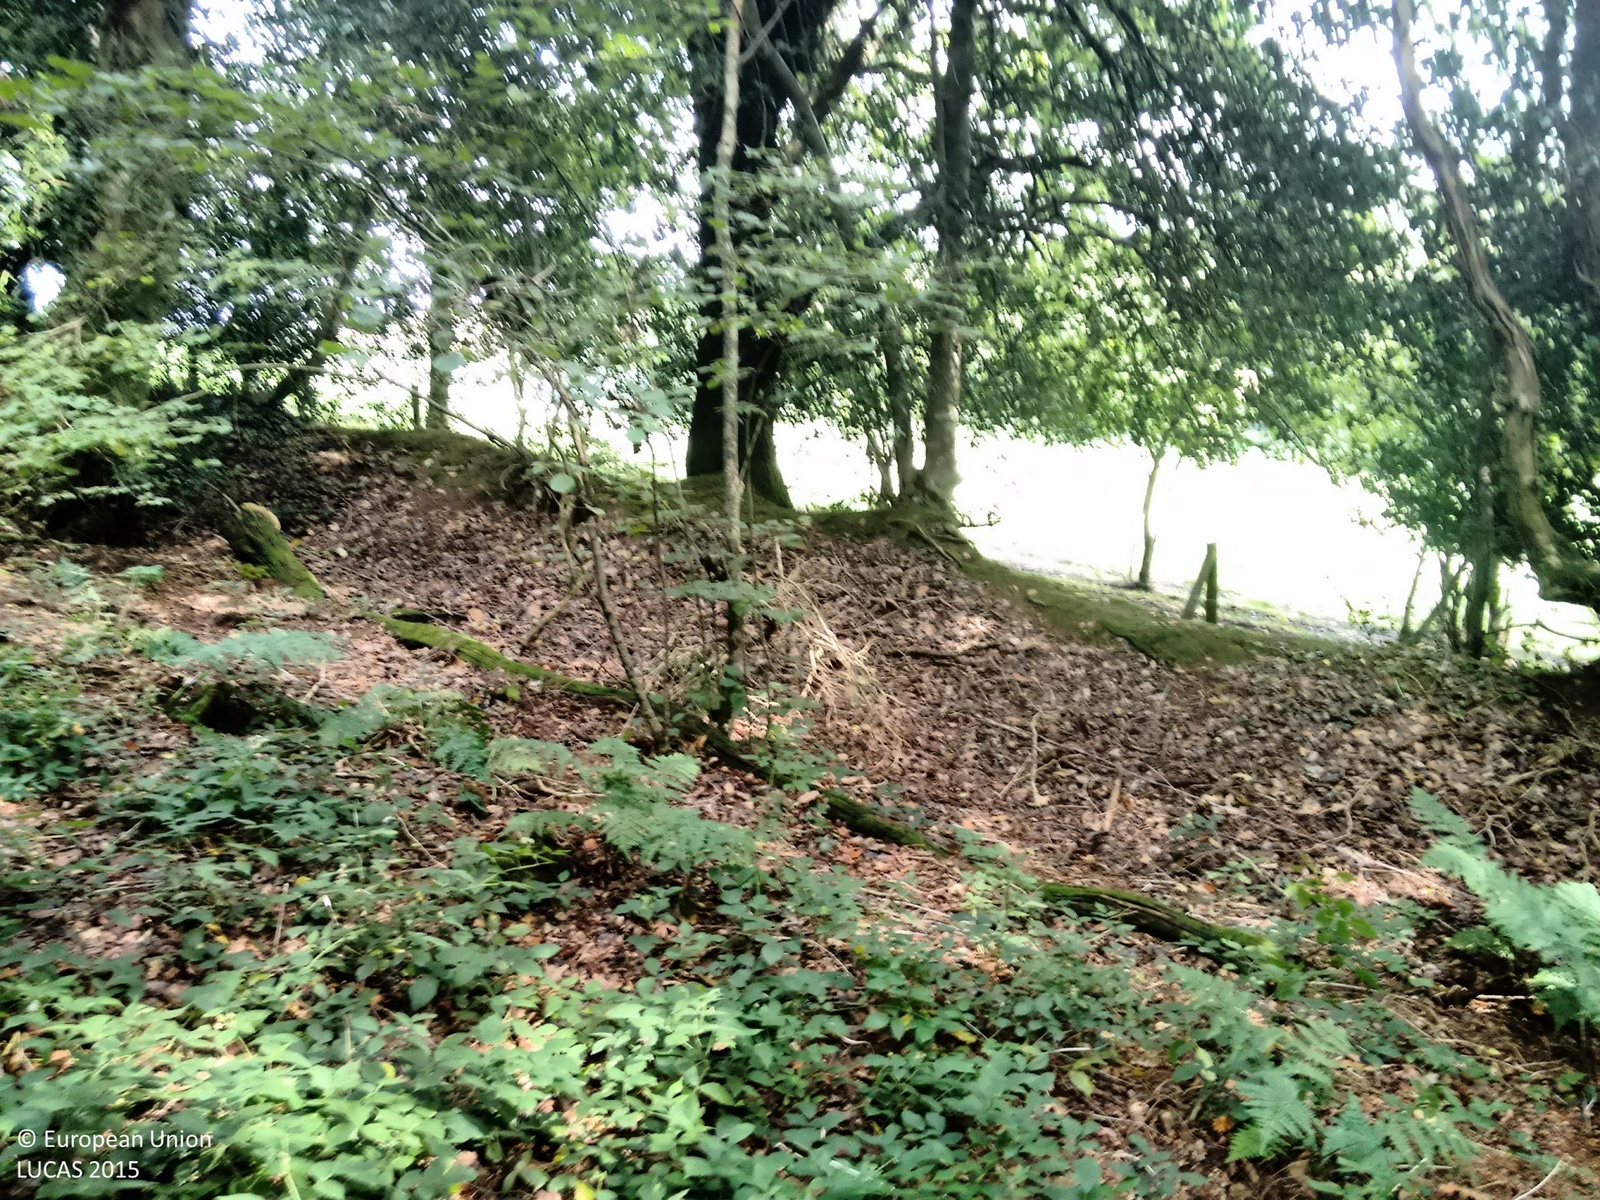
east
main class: Woodland
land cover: Spruce dominated mixed woodland
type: exotic forest
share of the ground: > 75 %
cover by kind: coniferous forest trees 60 %, broadleaved forest trees 40 %
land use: Forestry
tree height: > 5 m
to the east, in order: Spruce dominated mixed woodland; Fences; Broadleaved woodland; Fences; Broadleaved woodland; Grassland without tree/shrub cover; Single bushes/trees; Grassland without tree/shrub cover; Fences; Broadleaved woodland
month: September
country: GB
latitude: 50.7296
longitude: -4.3683
